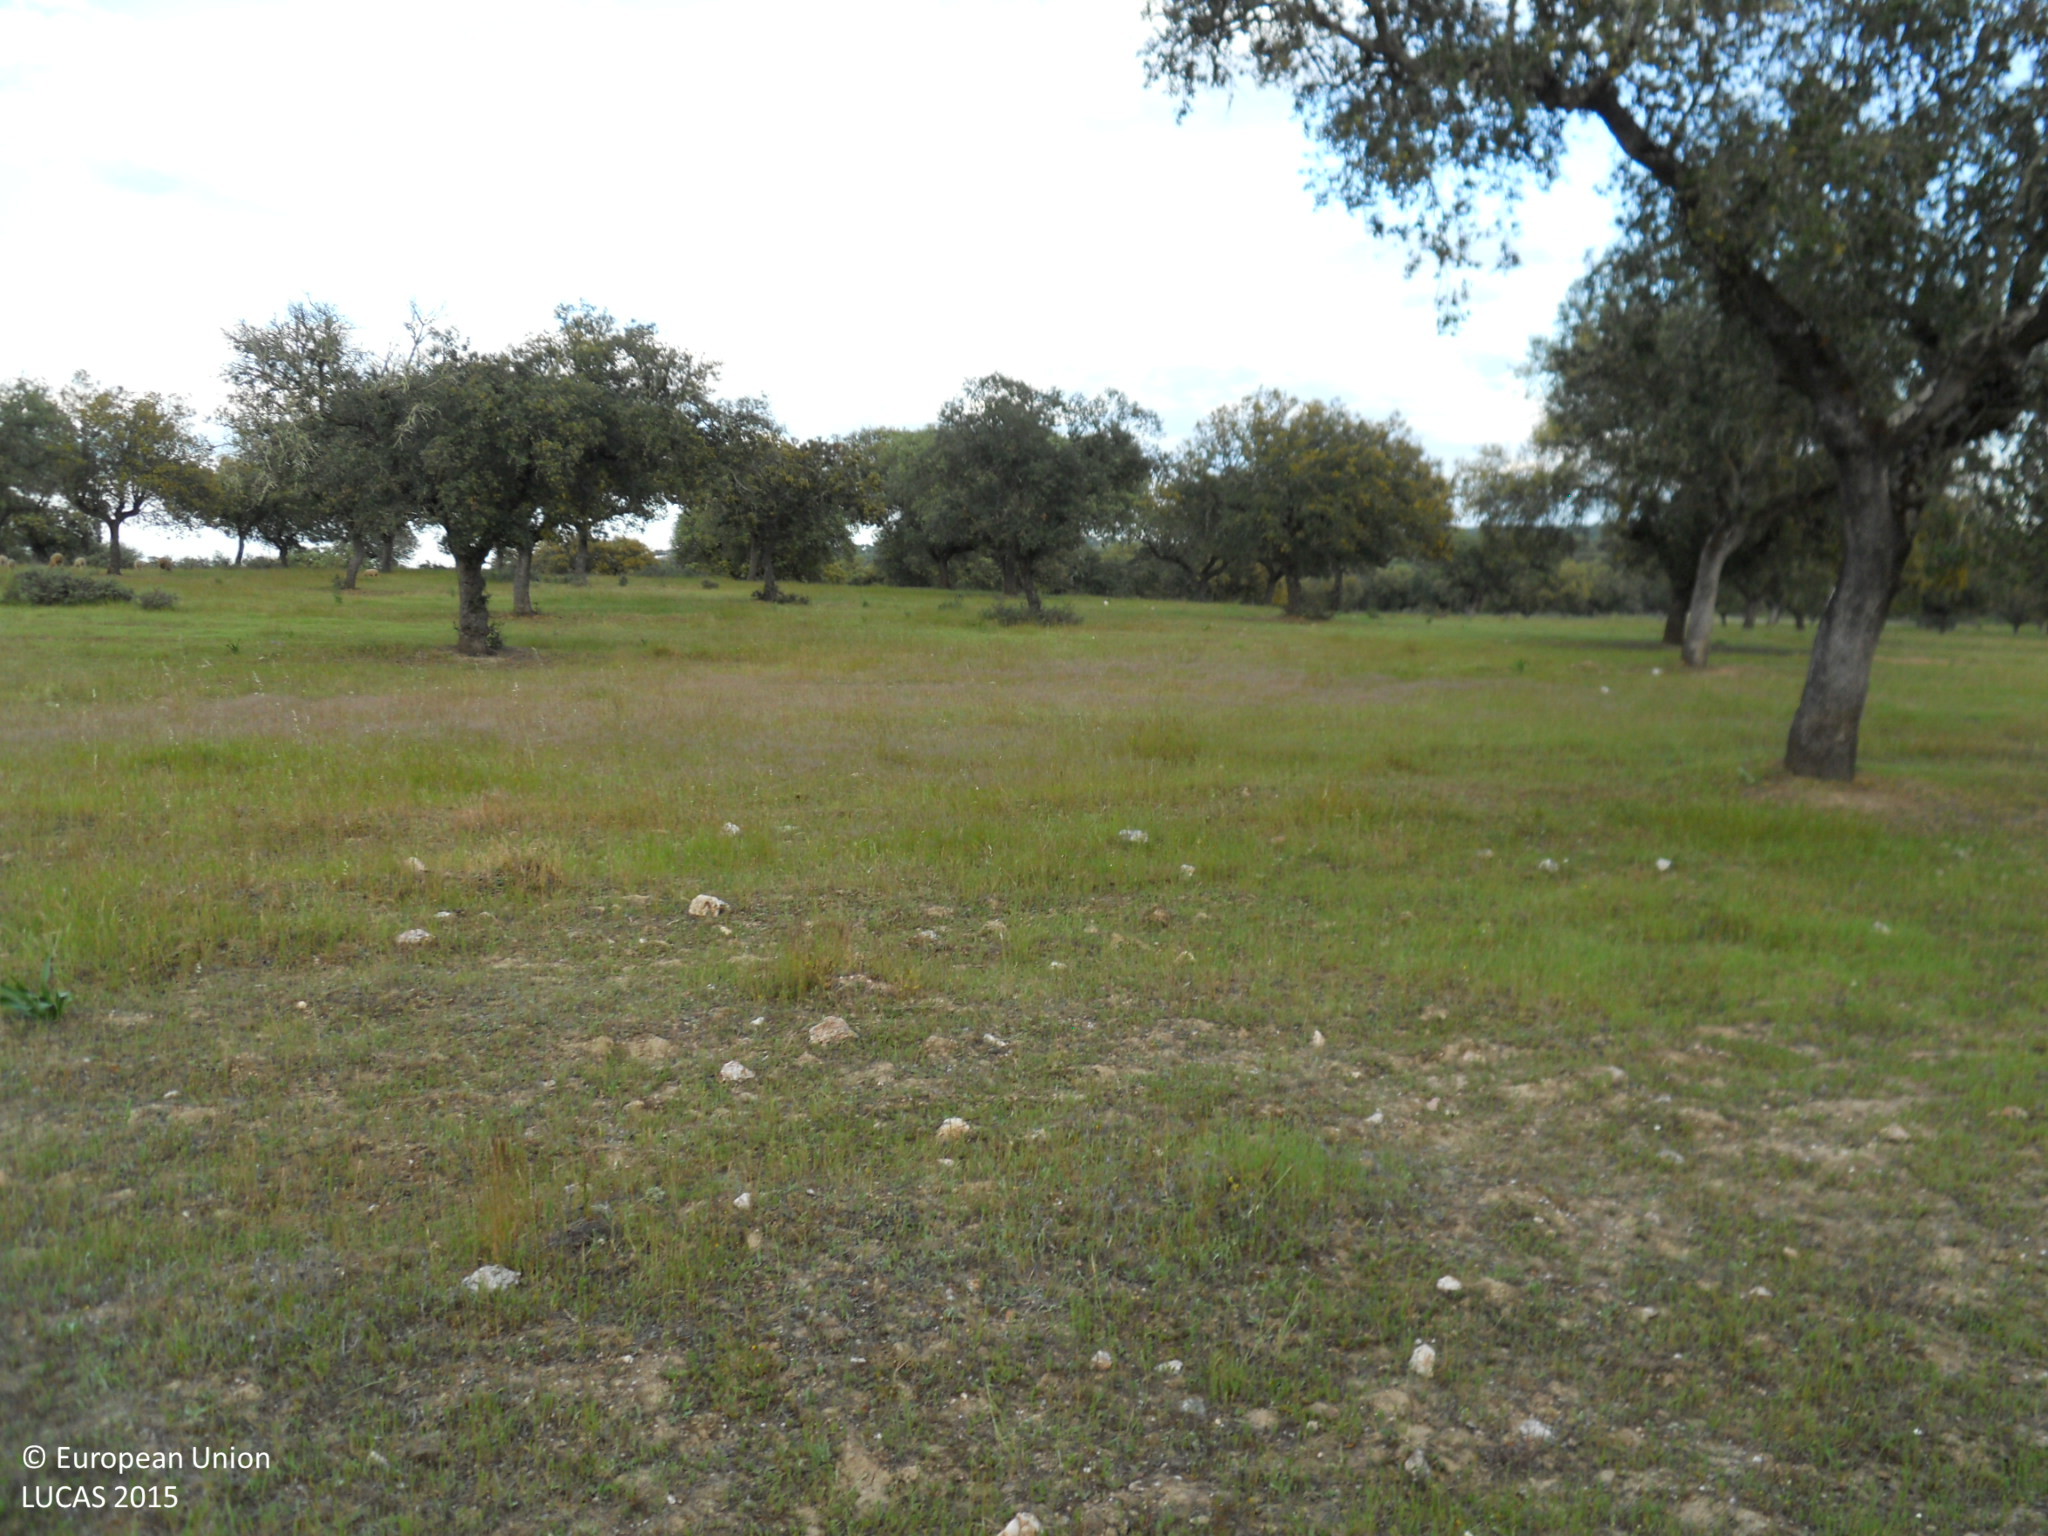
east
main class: Woodland
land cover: Broadleaved woodland
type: broadleaved evergreen forest
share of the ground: > 75 %
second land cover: Grassland without tree/shrub cover
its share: > 75 %
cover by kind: broadleaved forest trees 95 %, herbaceous plants 5 %
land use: Forestry
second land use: Agriculture (excluding fallow land and kitchen gardens)
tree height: > 5 m
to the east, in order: Broadleaved woodland; Grassland without tree/shrub cover; Fences; Other structural elements; Broadleaved woodland
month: April
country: ES
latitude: 39.2329
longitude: -6.7892
